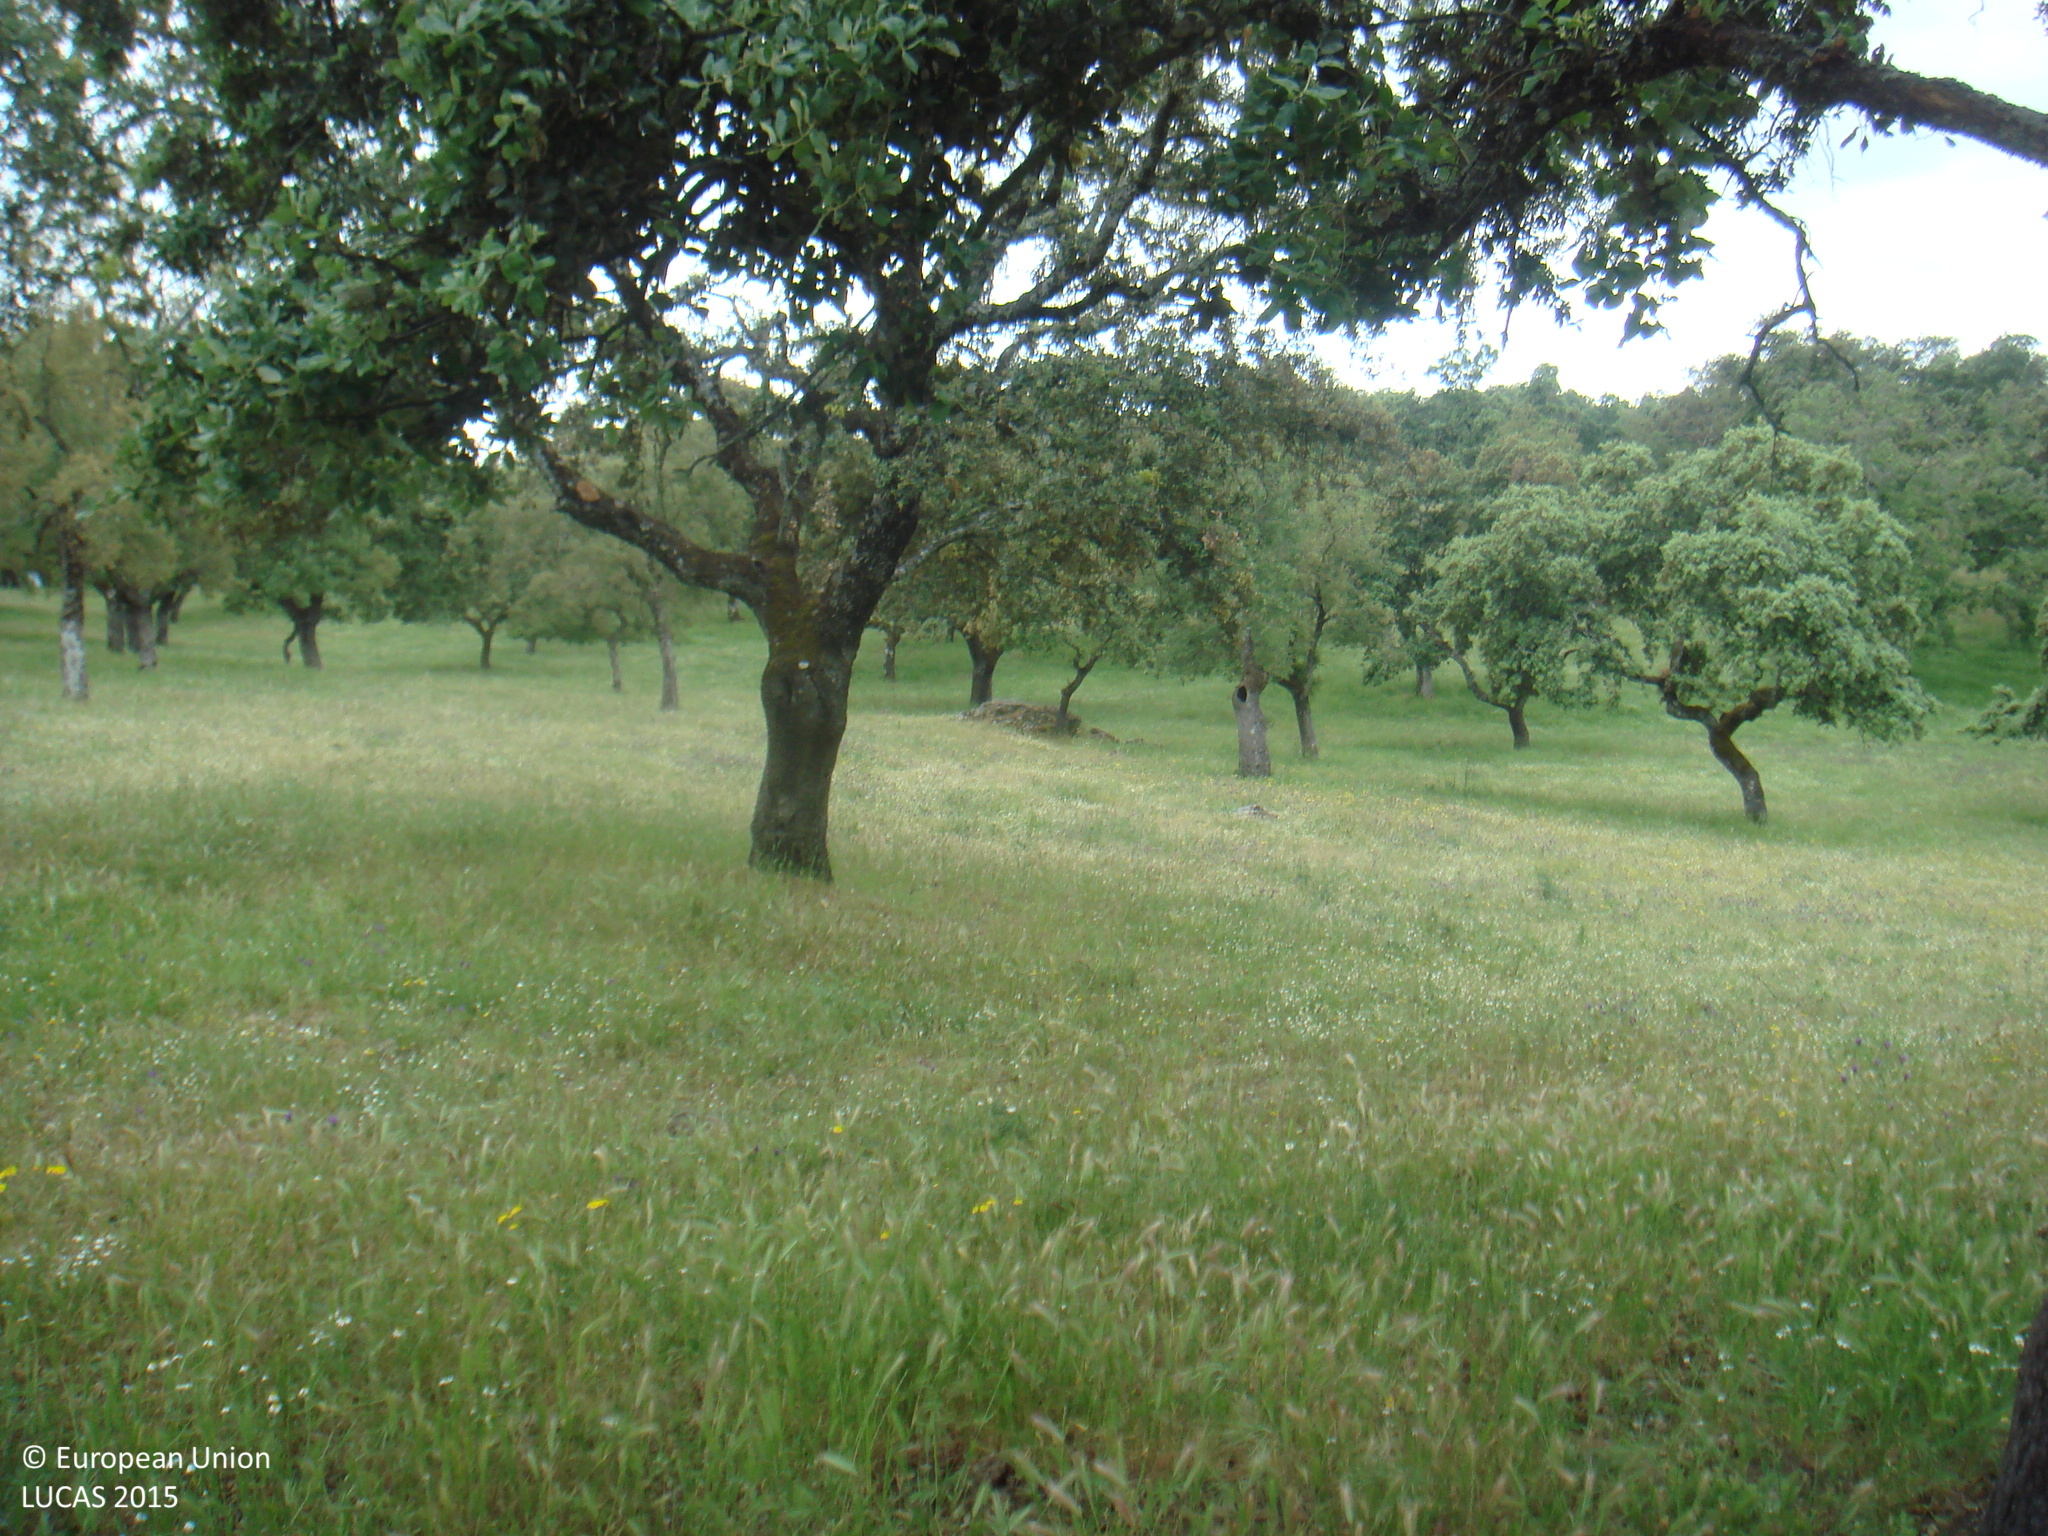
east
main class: Woodland
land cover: Broadleaved woodland
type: broadleaved evergreen forest
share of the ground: 25 - 50 %
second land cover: Grassland without tree/shrub cover
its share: 50 - 75 %
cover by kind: herbaceous plants 60 %, broadleaved forest trees 40 %
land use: Forestry
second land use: Agriculture (excluding fallow land and kitchen gardens)
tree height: > 5 m
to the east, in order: Broadleaved woodland; Grassland without tree/shrub cover; Rock outcrops; Grassland with sparse tree/shrub cover; Broadleaved woodland; Fences; Broadleaved woodland
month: May
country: ES
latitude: 38.2442
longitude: -4.4006
